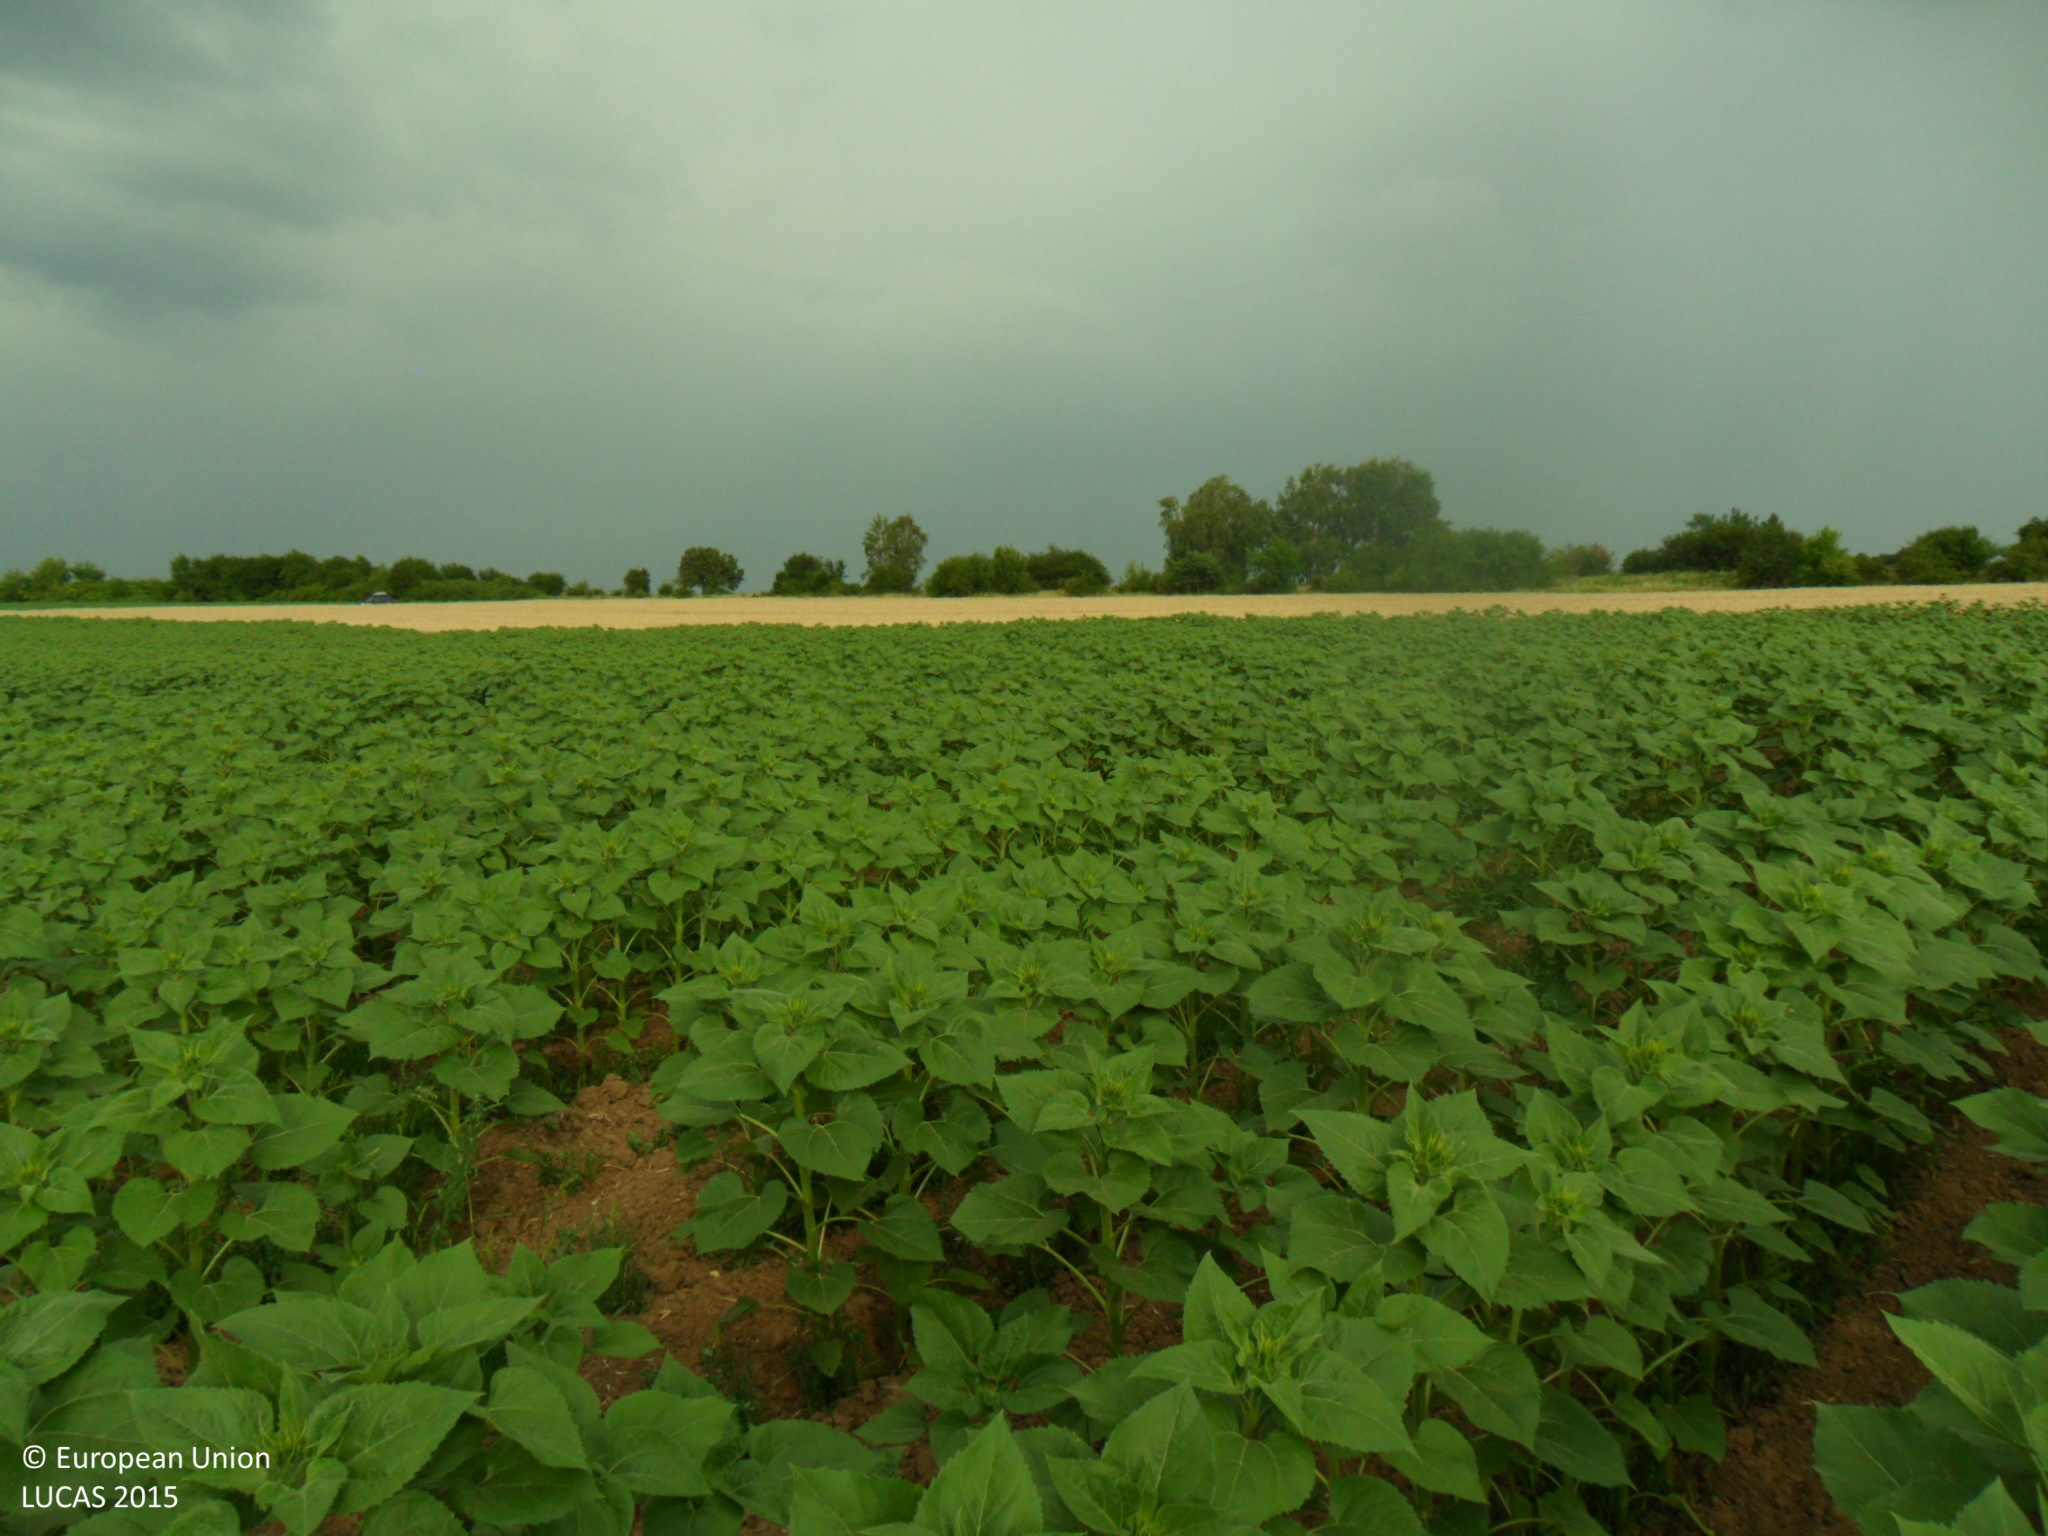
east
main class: Cropland
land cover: Sunflower
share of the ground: > 75 %
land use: Agriculture (excluding fallow land and kitchen gardens)
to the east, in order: Sunflower; Grass margins; Common wheat; Grass margins; Tracks; Sunflower; Grass margins; Shrubland without tree cover; Sunflower
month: July
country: BG
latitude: 43.5730
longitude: 26.8174
